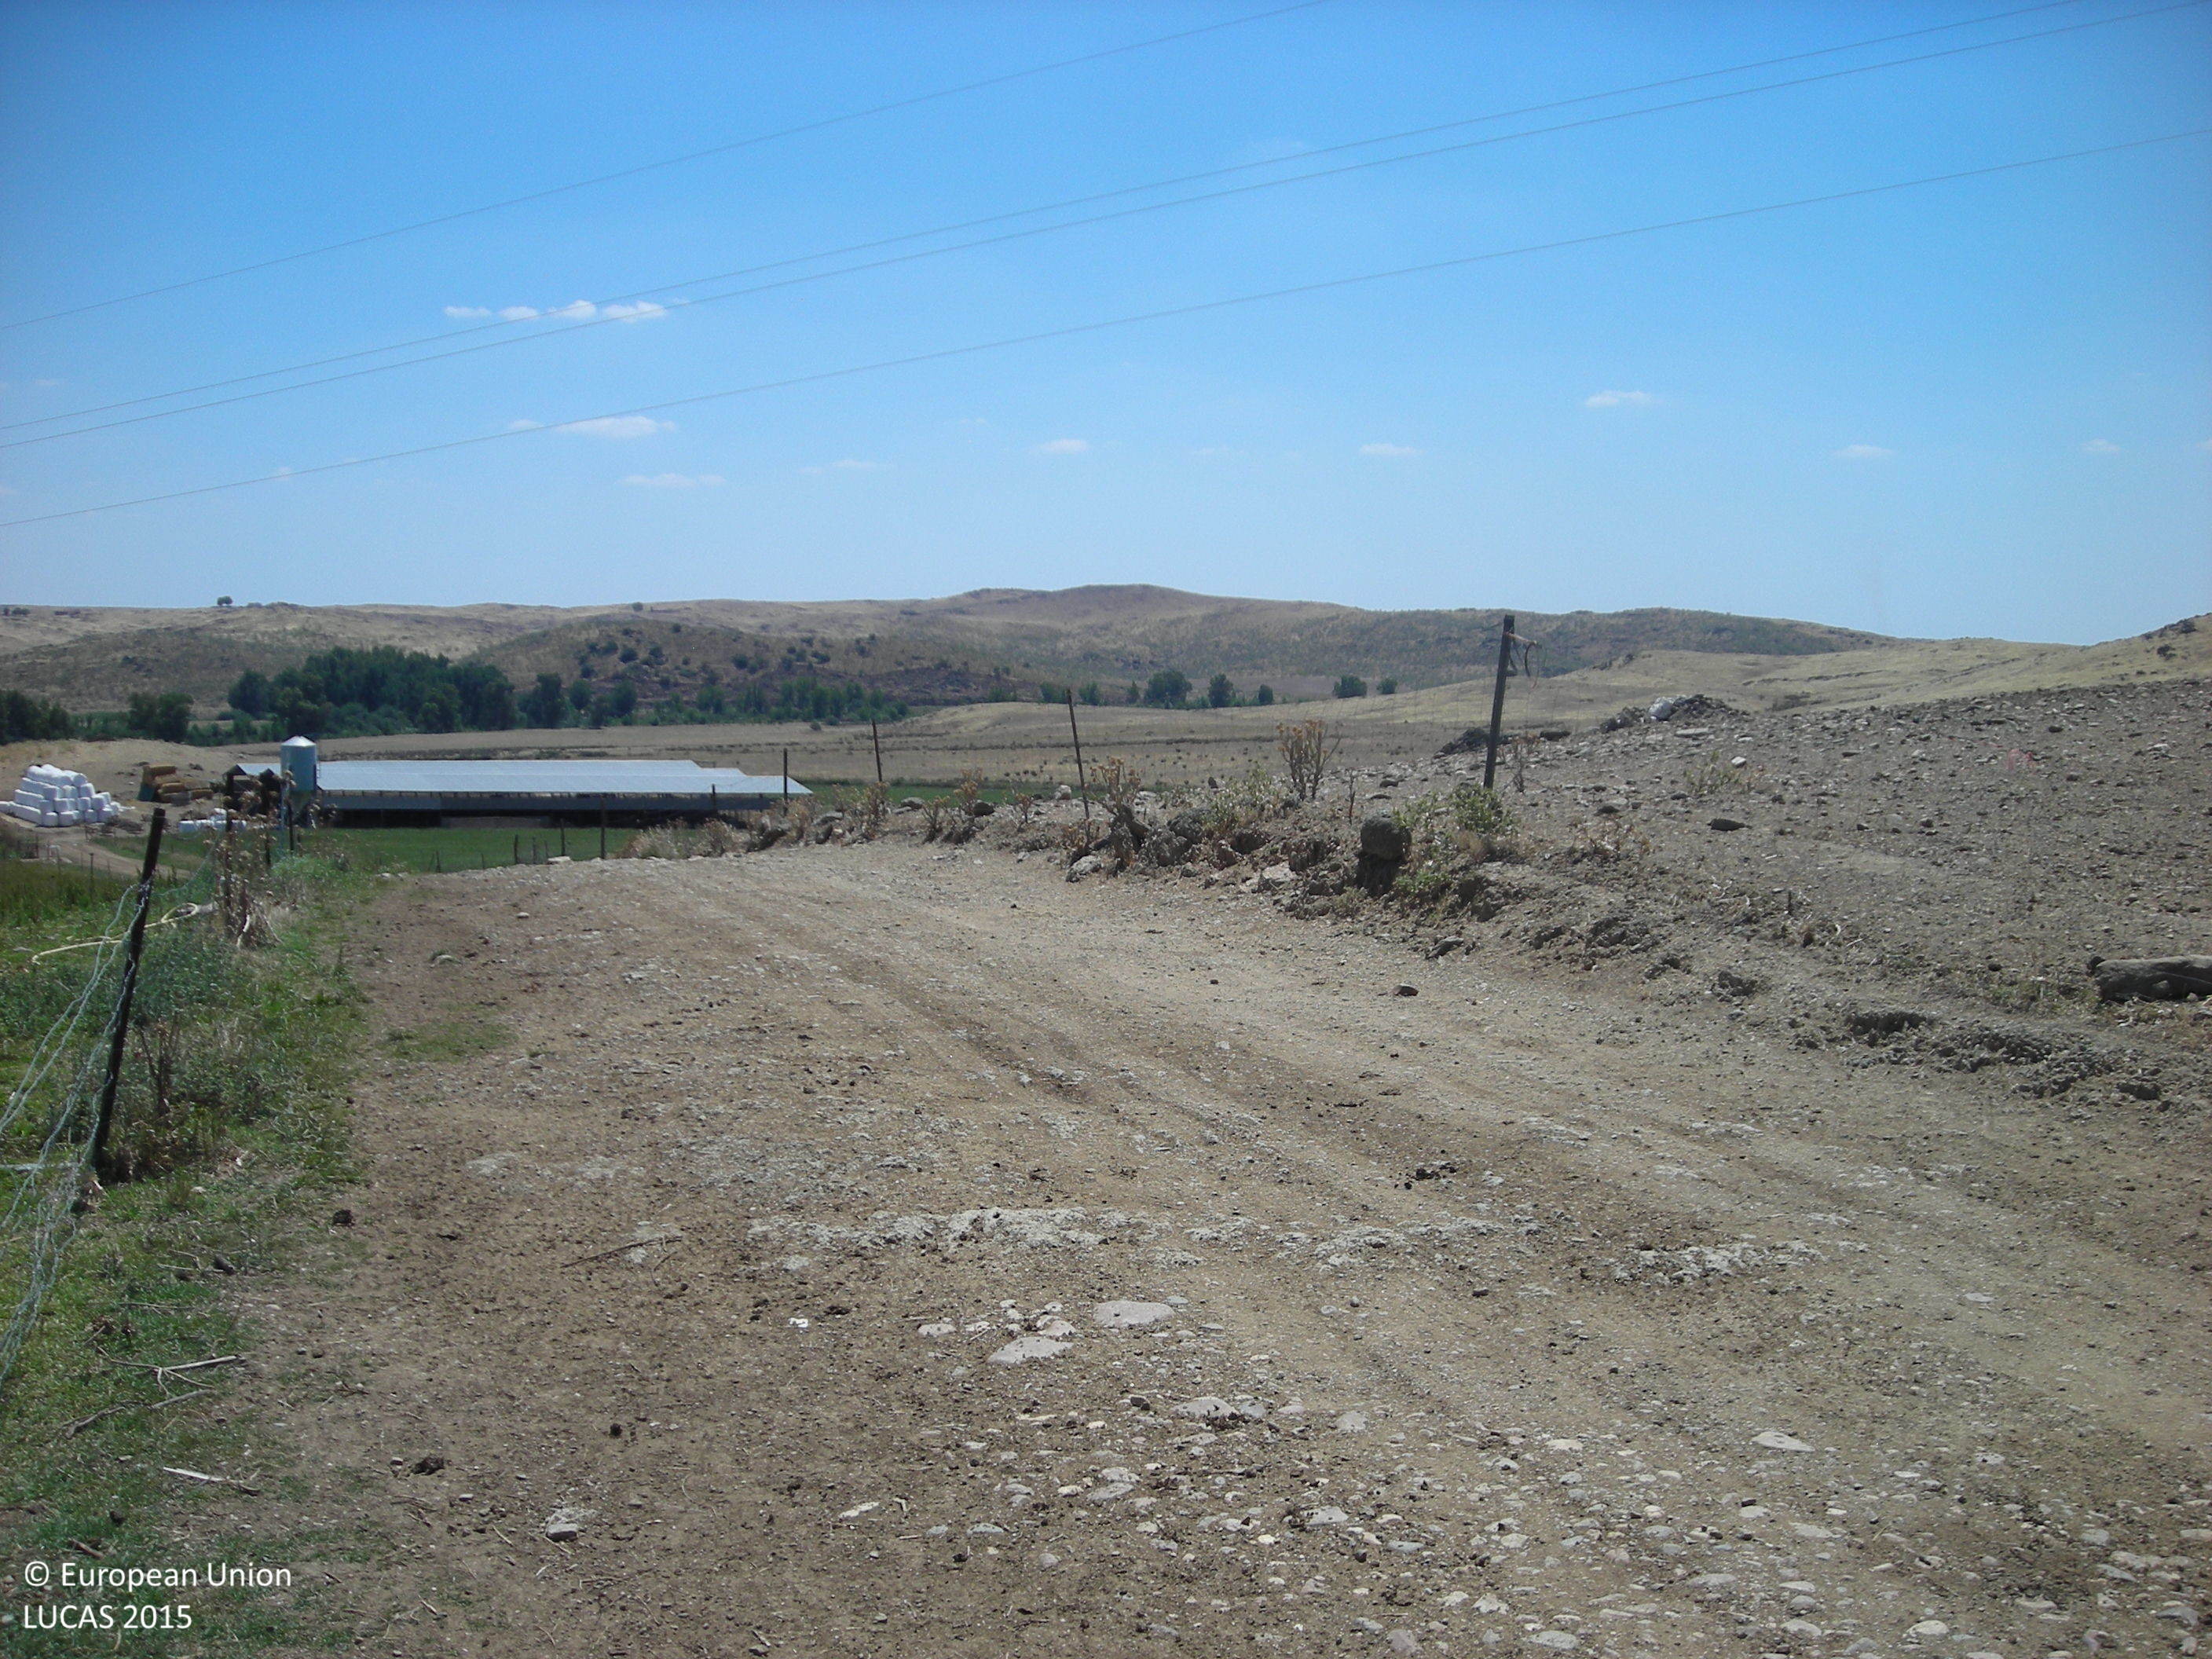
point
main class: Cropland
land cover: Mixed cereals for fodder
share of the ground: > 75 %
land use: Agriculture (excluding fallow land and kitchen gardens)
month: June
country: ES
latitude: 38.9191
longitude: -5.4856
